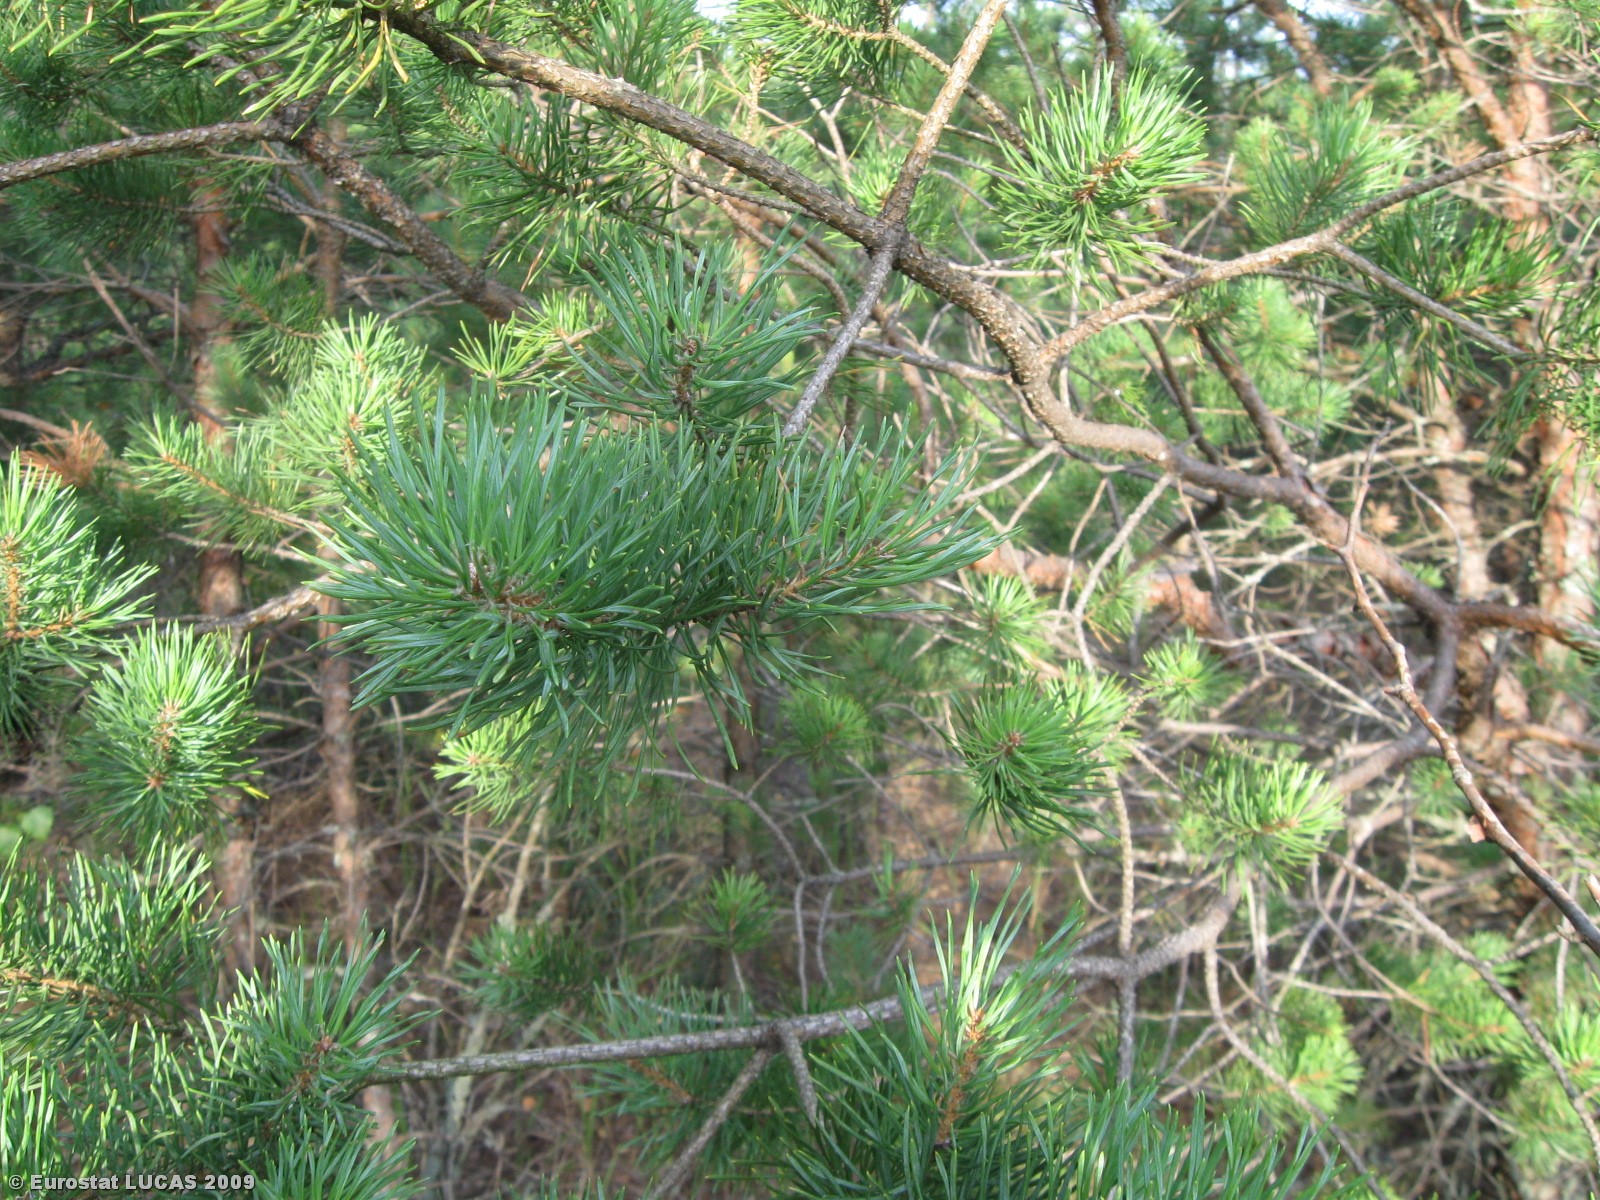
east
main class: Woodland
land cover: Mixed woodland
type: hemiboreal forest and nemoral coniferous forest and mixed broadleaved-coniferous forest
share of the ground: > 75 %
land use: Forestry
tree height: > 5 m
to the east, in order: Mixed woodland; Tracks; Coniferous woodland; Tracks; Mixed woodland; Grass margins; Tracks; Grass margins; Mixed woodland
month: August
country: LT
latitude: 55.0853
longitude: 22.6447
